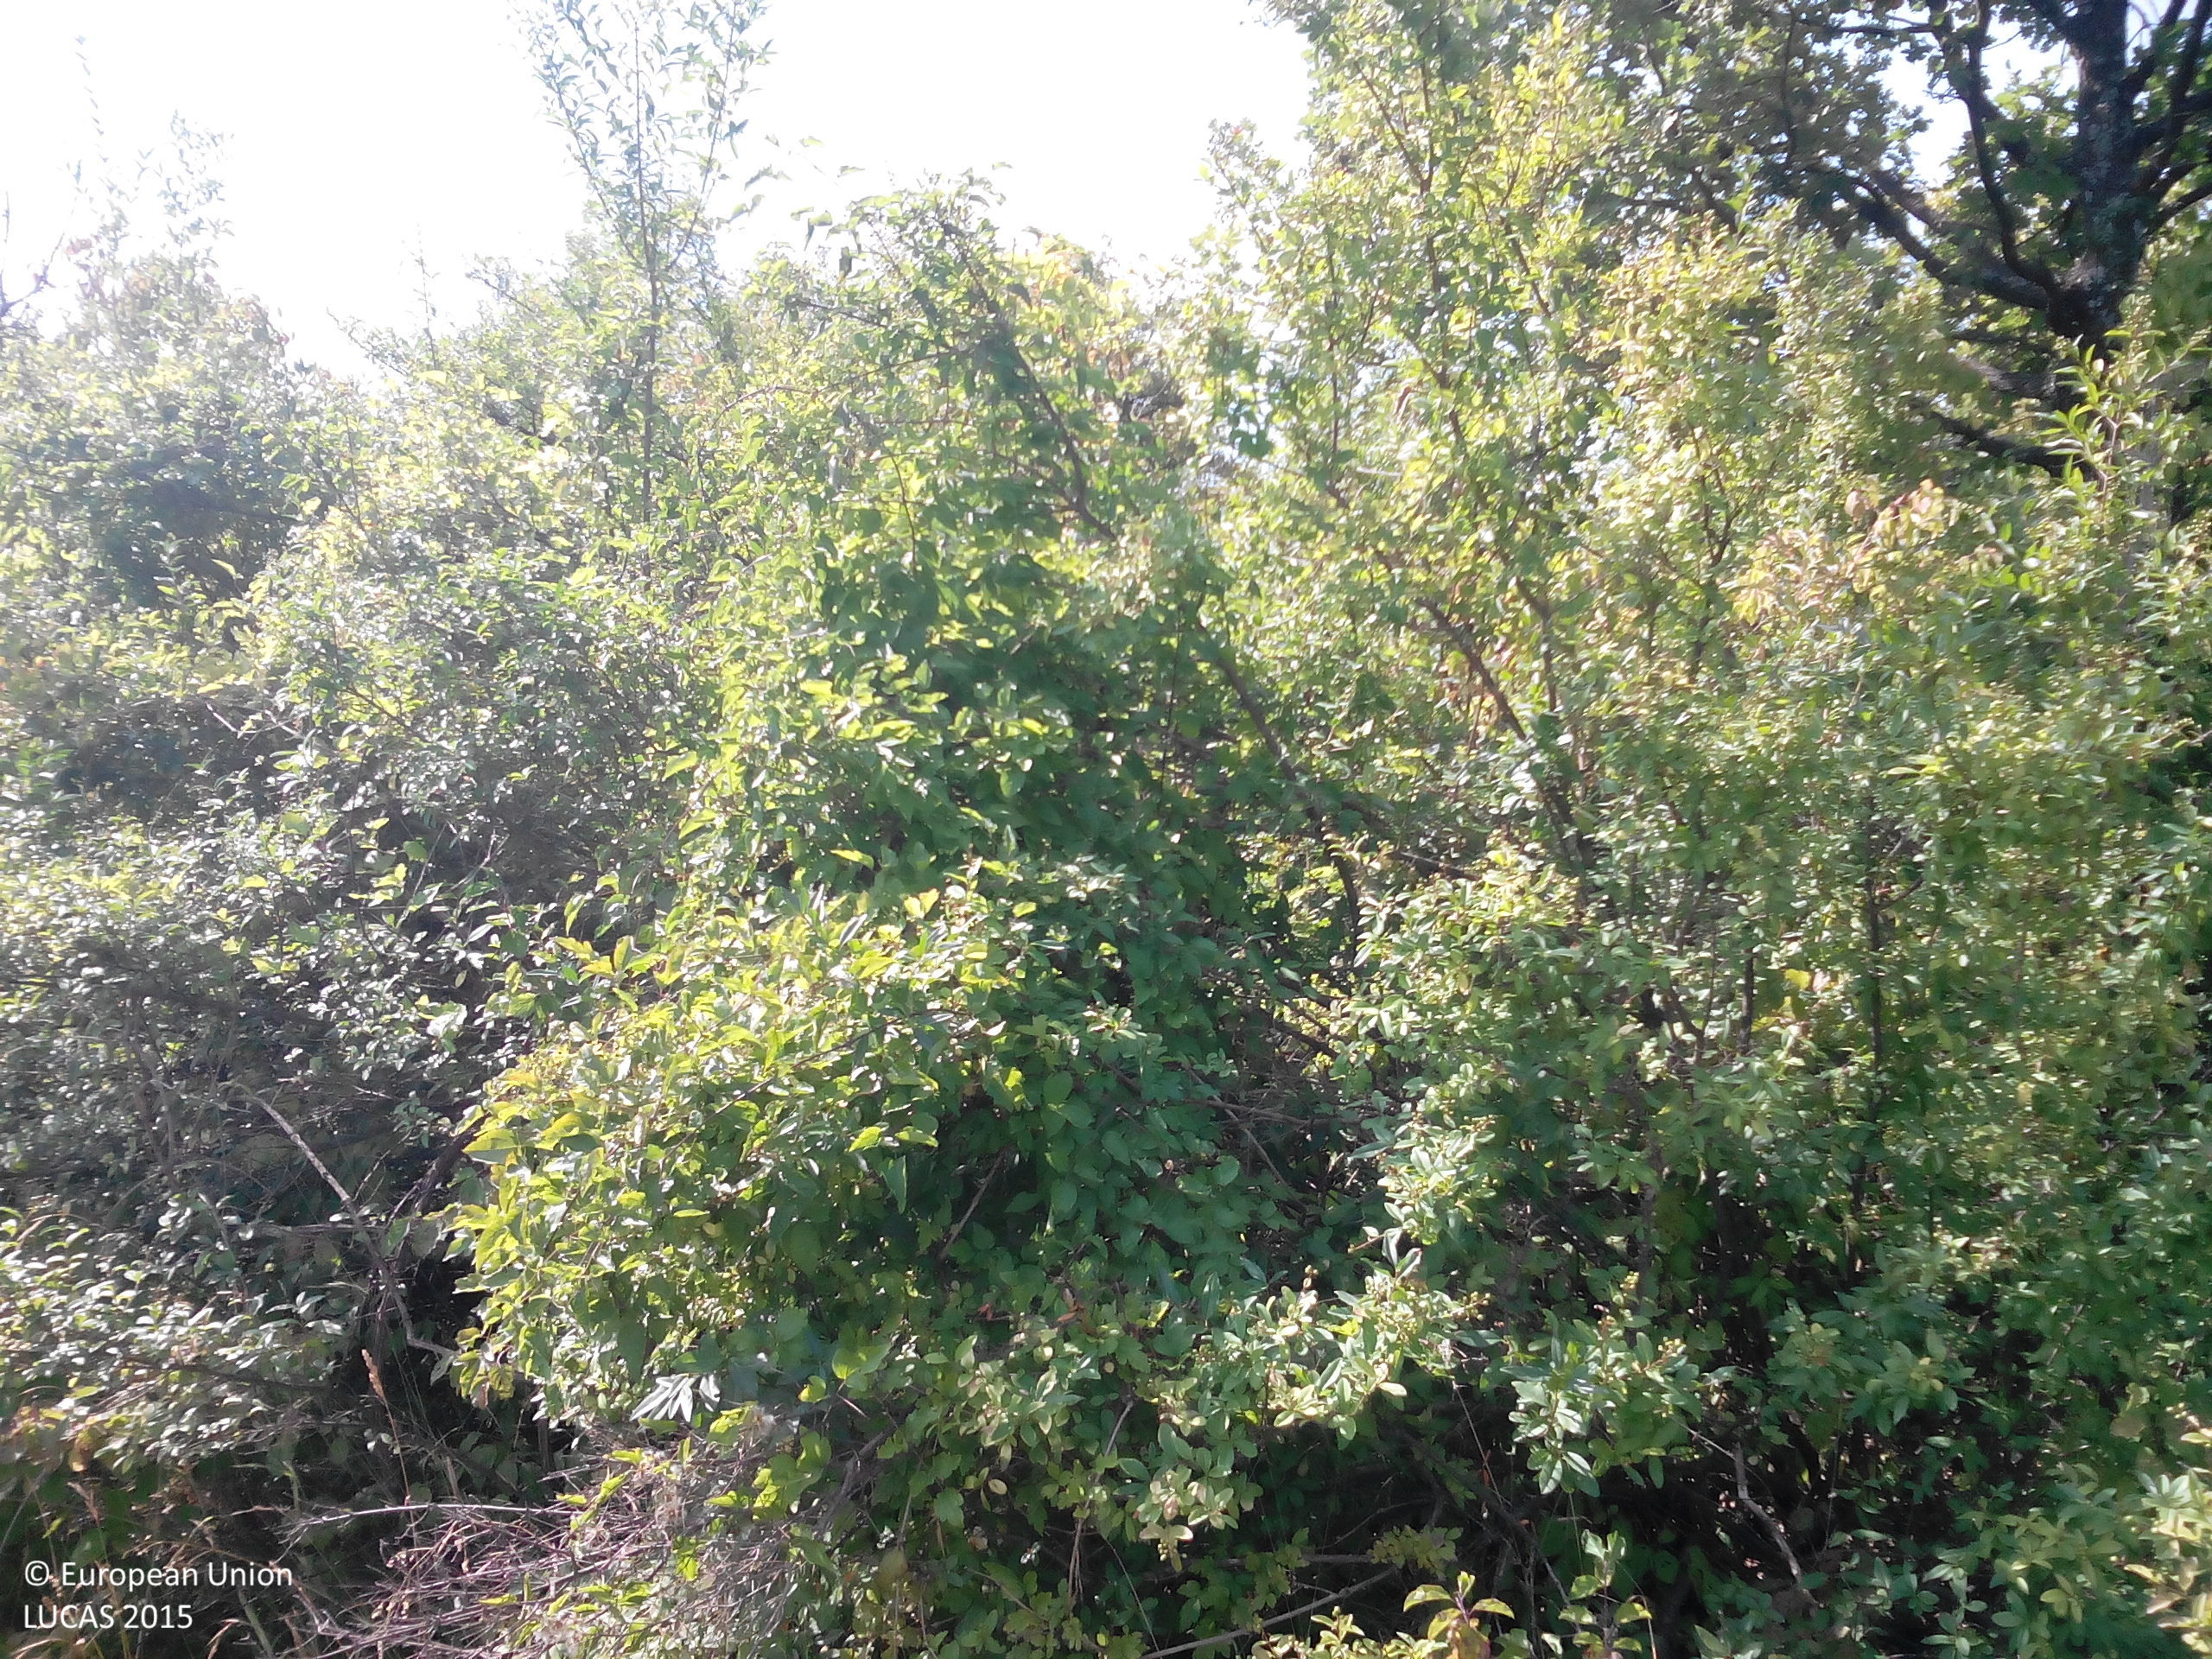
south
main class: Woodland
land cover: Broadleaved woodland
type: mesophytic deciduous forest
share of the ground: 25 - 50 %
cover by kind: shrubs 65 %, broadleaved forest trees 35 %
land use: Semi-natural and natural areas not in use
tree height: > 5 m
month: August
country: BG
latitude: 43.1517
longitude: 23.7815
